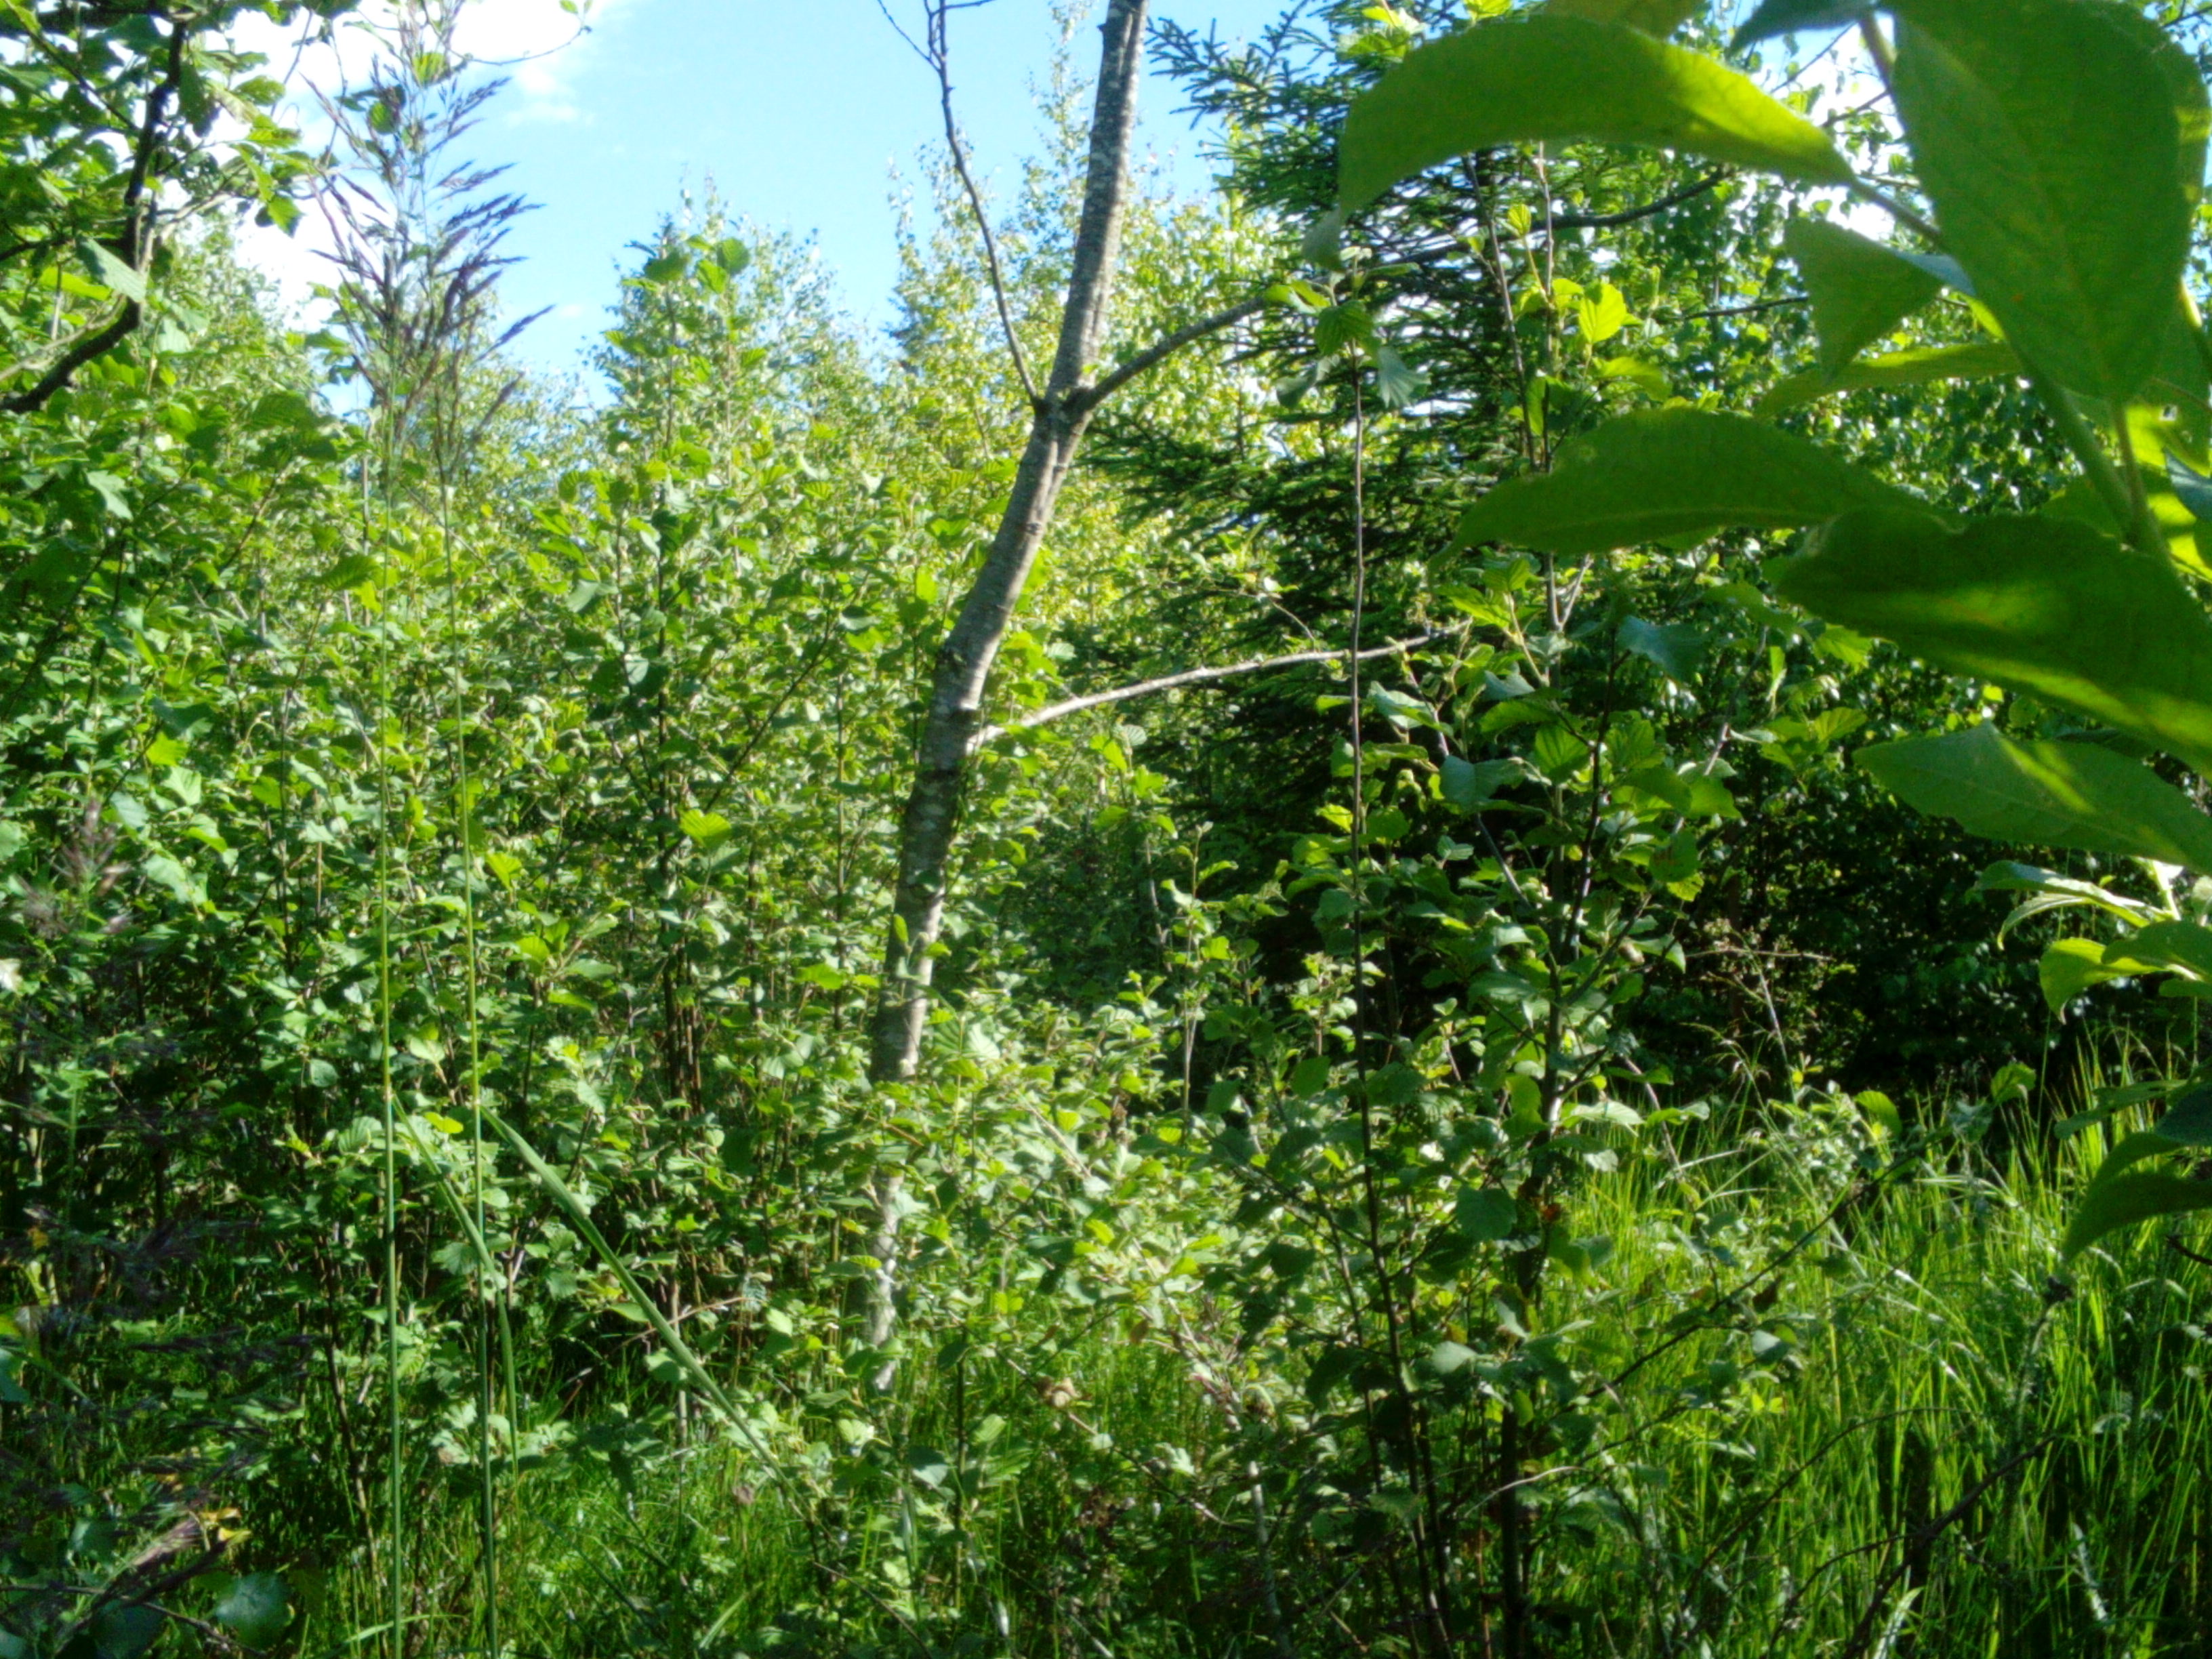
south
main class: Woodland
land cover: Broadleaved woodland
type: non-riverine alder, birch or aspen forest
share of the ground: > 75 %
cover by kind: broadleaved forest trees 75 %, herbaceous plants 15 %, coniferous forest trees 5 %, shrubs 5 %
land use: Forestry
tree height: < 5 m
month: July
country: LV
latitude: 56.4909
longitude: 22.0527
